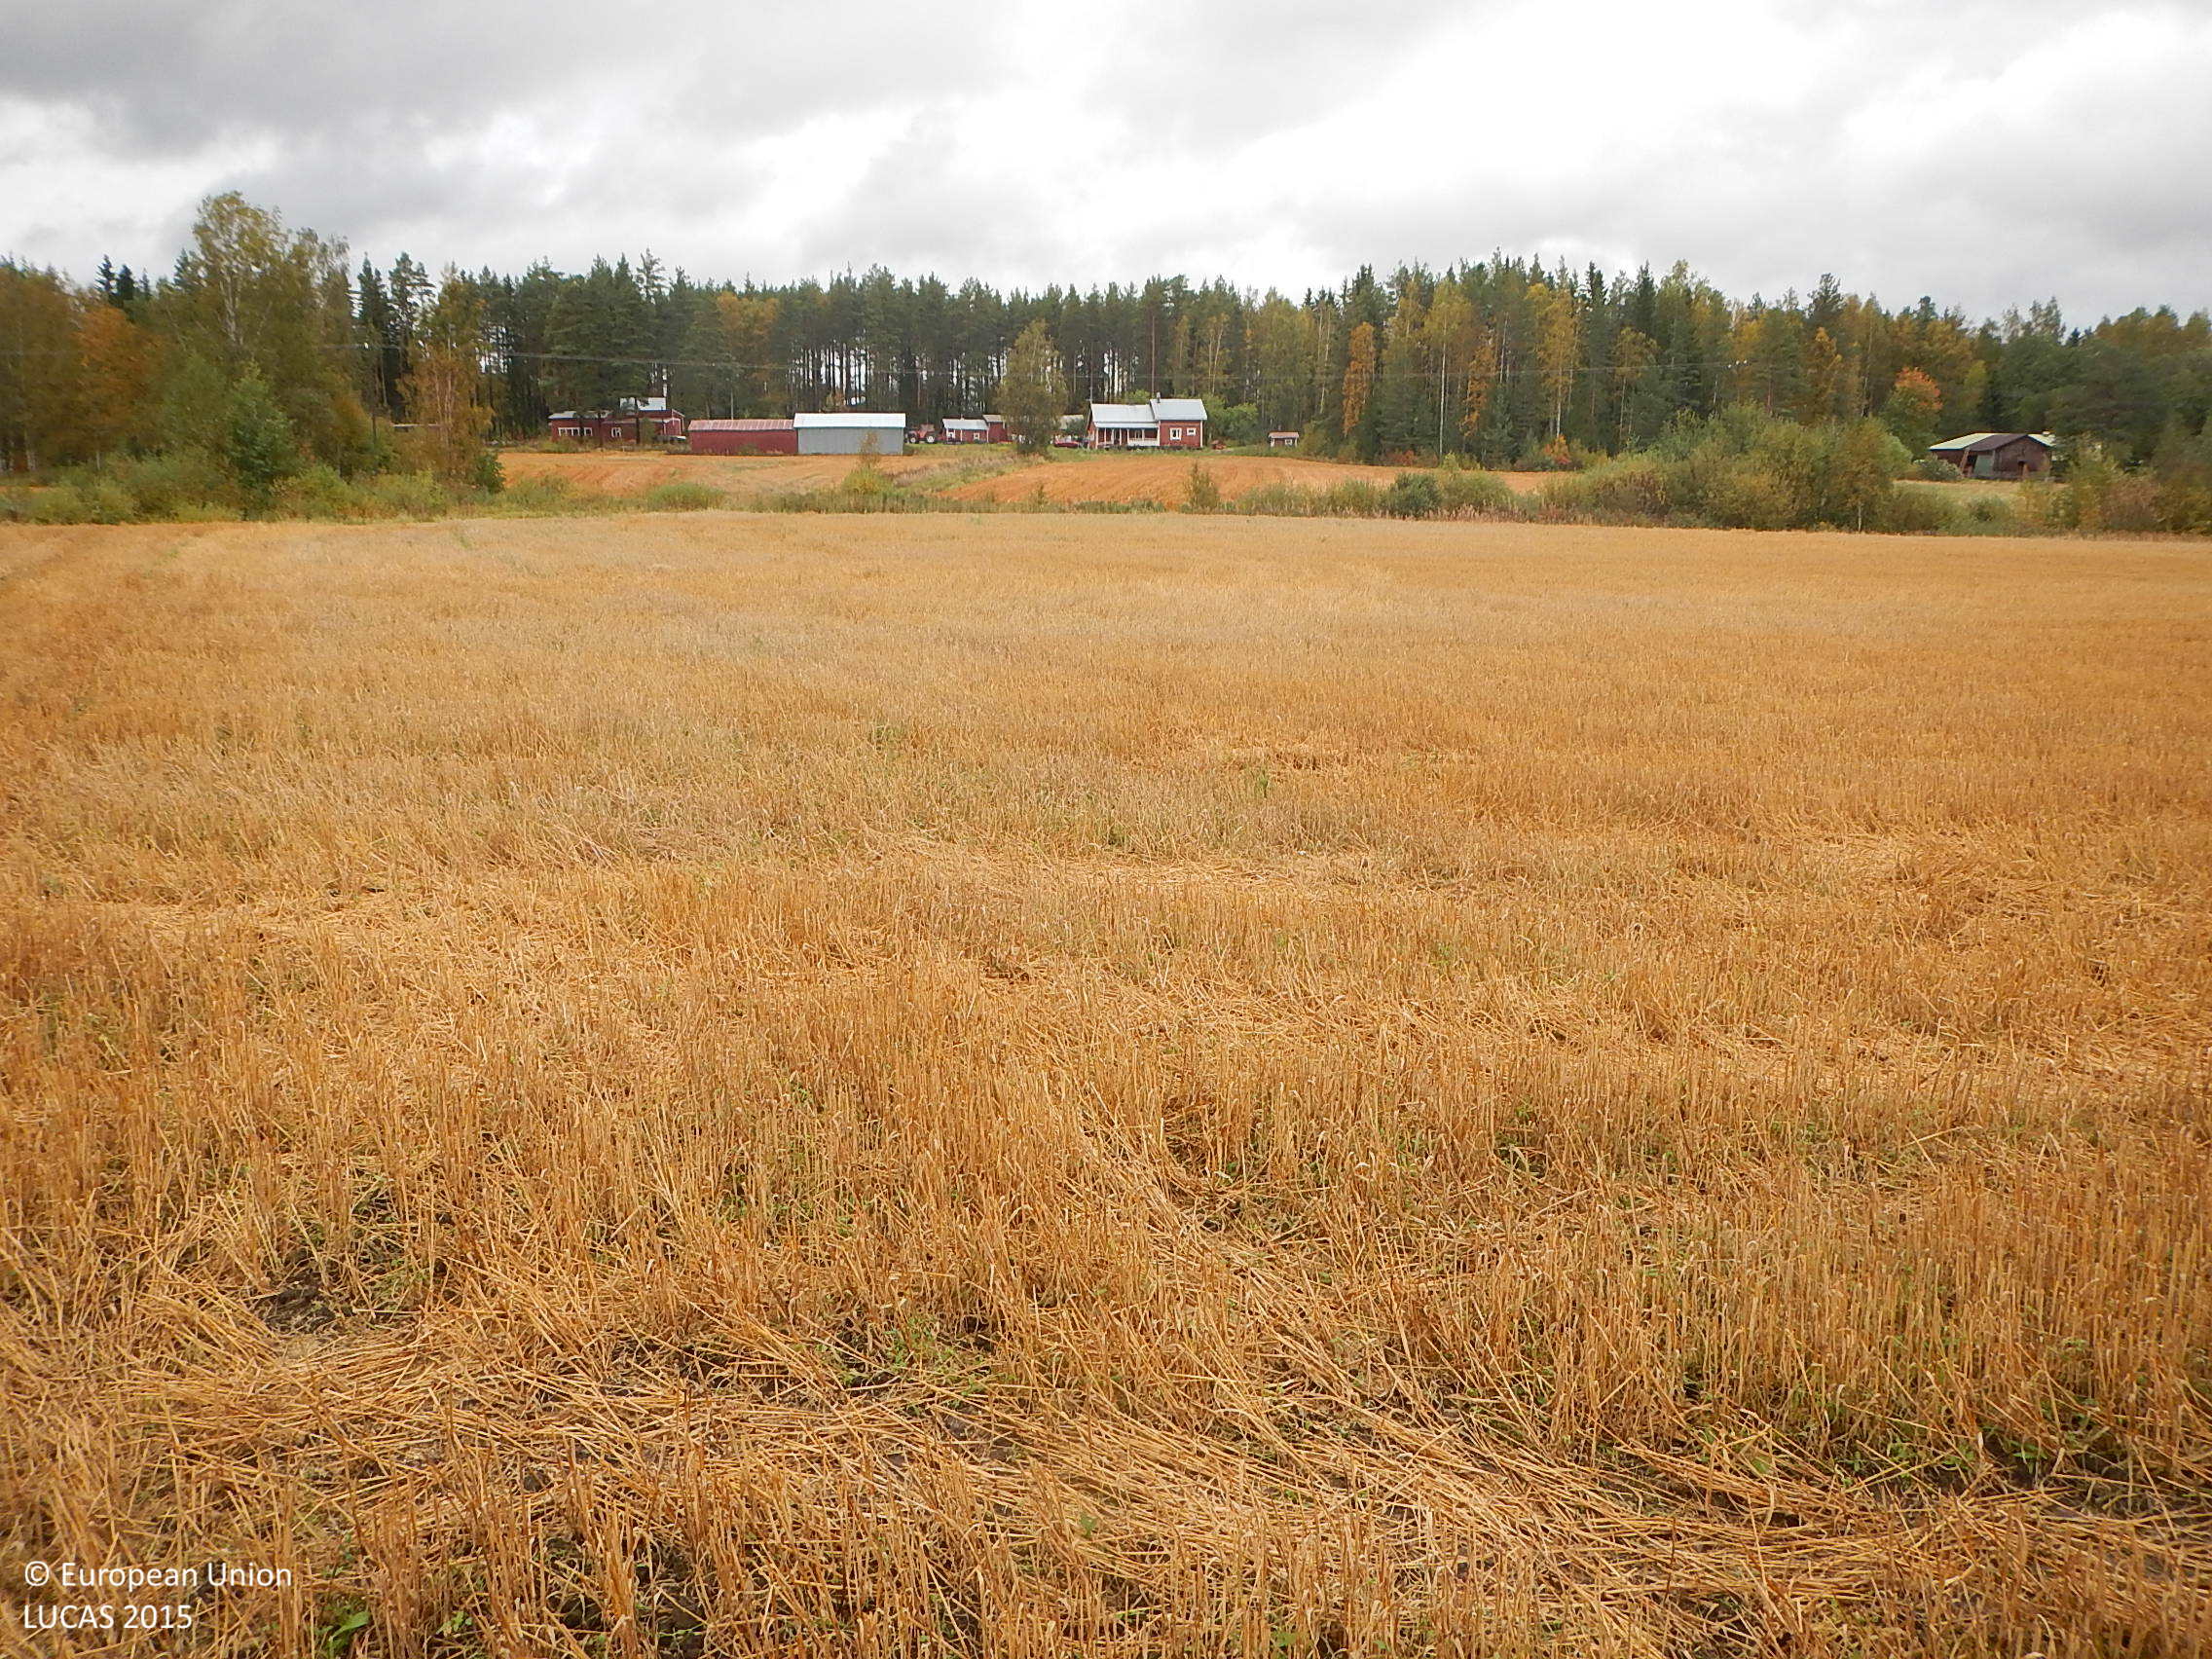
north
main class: Cropland
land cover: Barley
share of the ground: > 75 %
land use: Agriculture (excluding fallow land and kitchen gardens)
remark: Harvested field
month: September
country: FI
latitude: 61.8696
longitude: 22.2828
